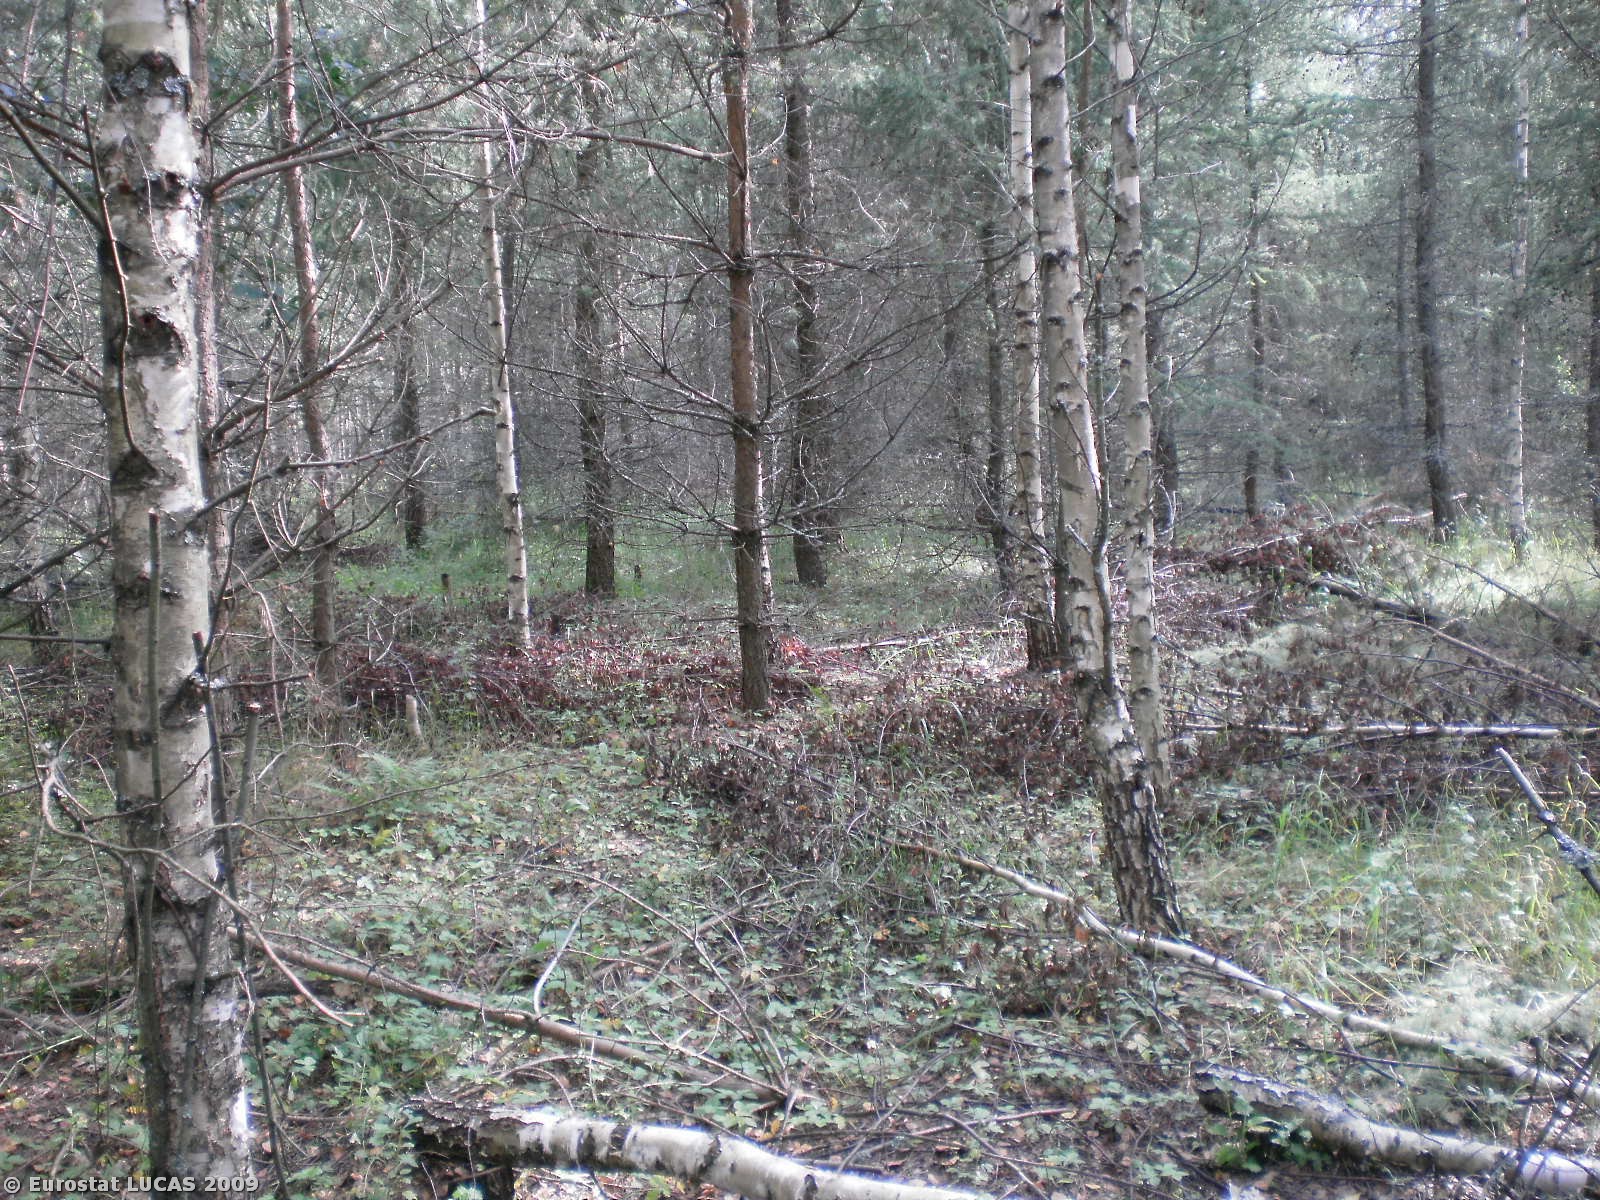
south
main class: Woodland
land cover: Mixed woodland
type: hemiboreal forest and nemoral coniferous forest and mixed broadleaved-coniferous forest
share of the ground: > 75 %
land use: Forestry
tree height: > 5 m
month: July
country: PL
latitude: 53.8117
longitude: 19.8866
